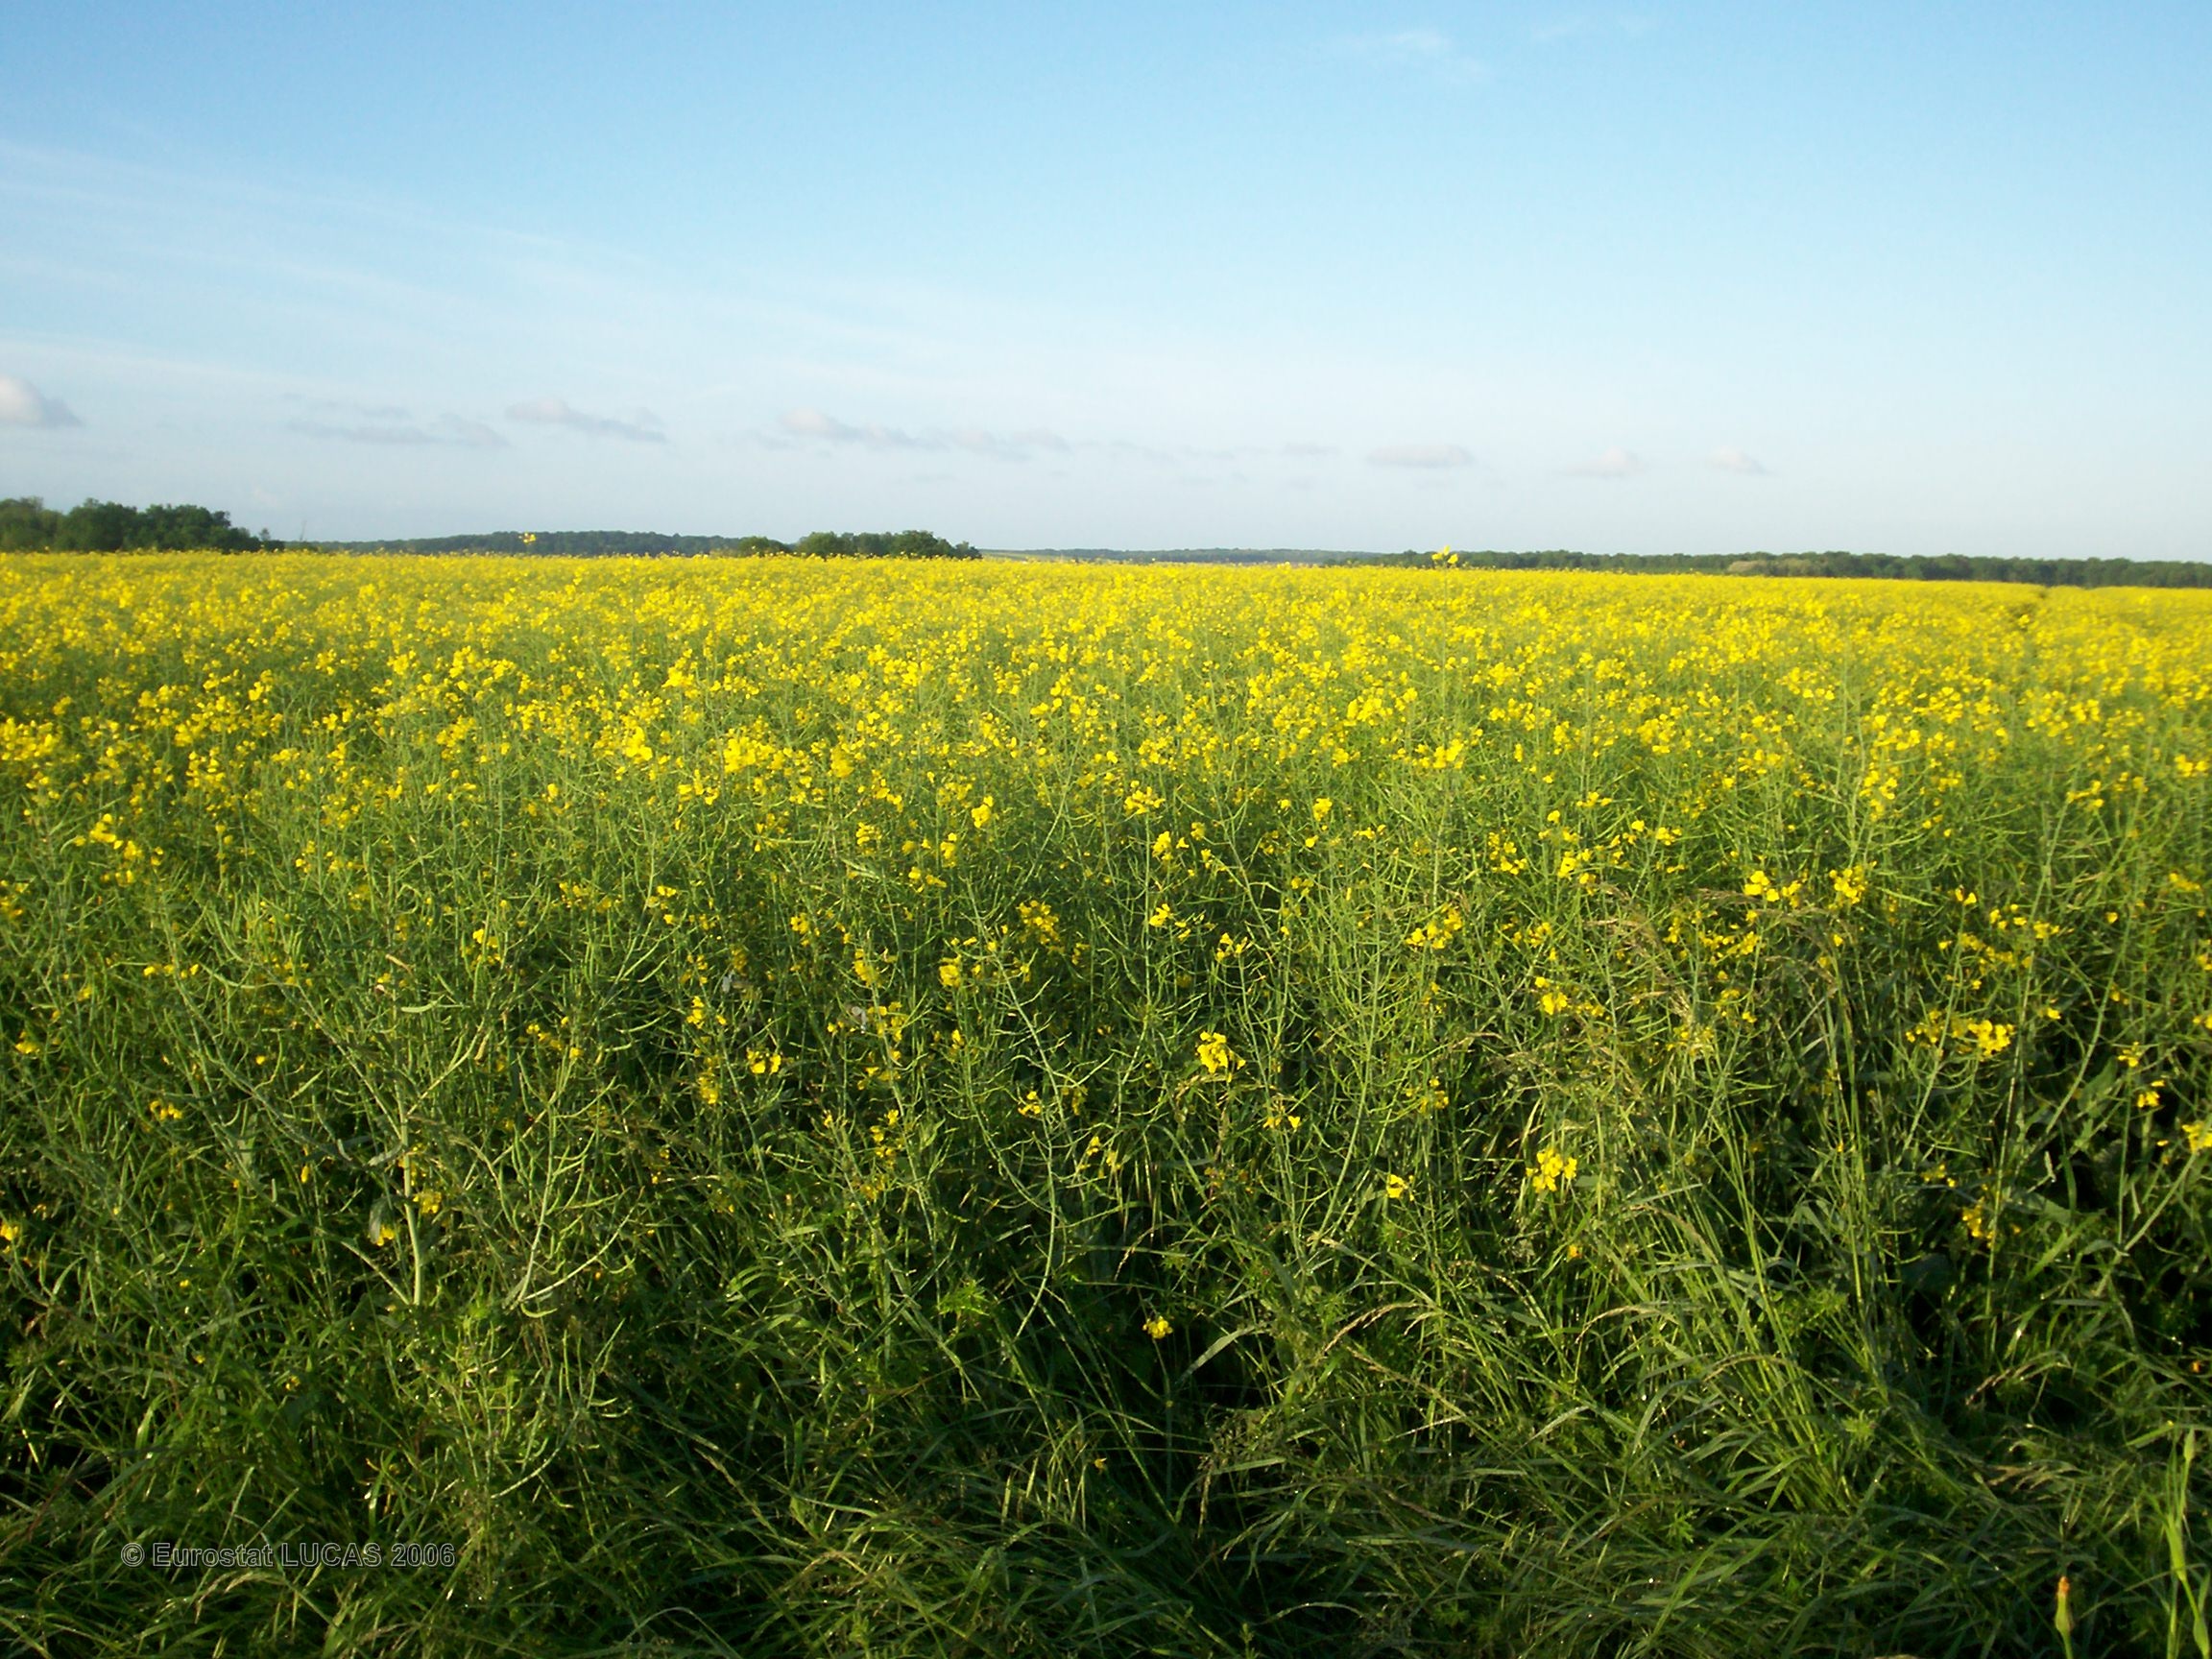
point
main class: Cropland
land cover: Rape and turnip rape
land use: Agriculture (excluding fallow land and kitchen gardens)
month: May
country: FR
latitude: 47.3494
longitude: 5.3280
